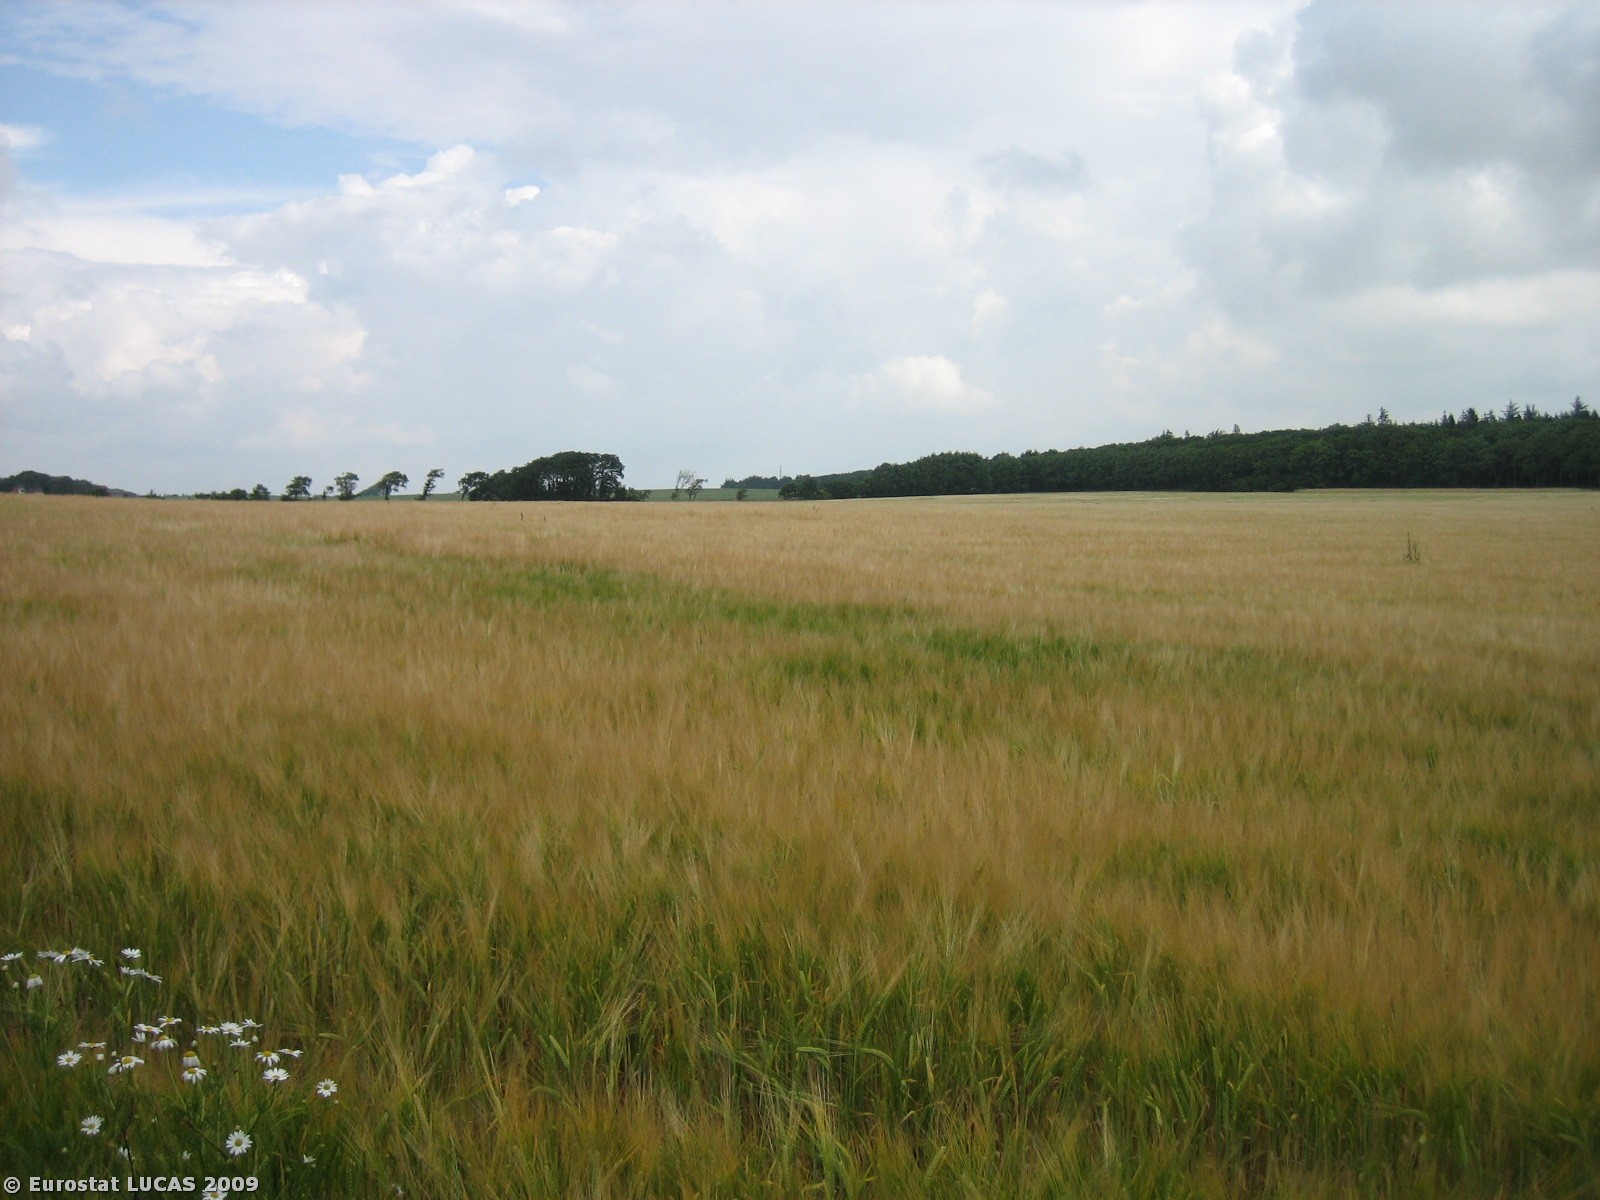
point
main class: Cropland
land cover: Barley
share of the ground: > 75 %
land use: Agriculture (excluding fallow land and kitchen gardens)
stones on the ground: 10 - 25 %
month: July
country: DK
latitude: 55.5332
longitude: 8.6228
